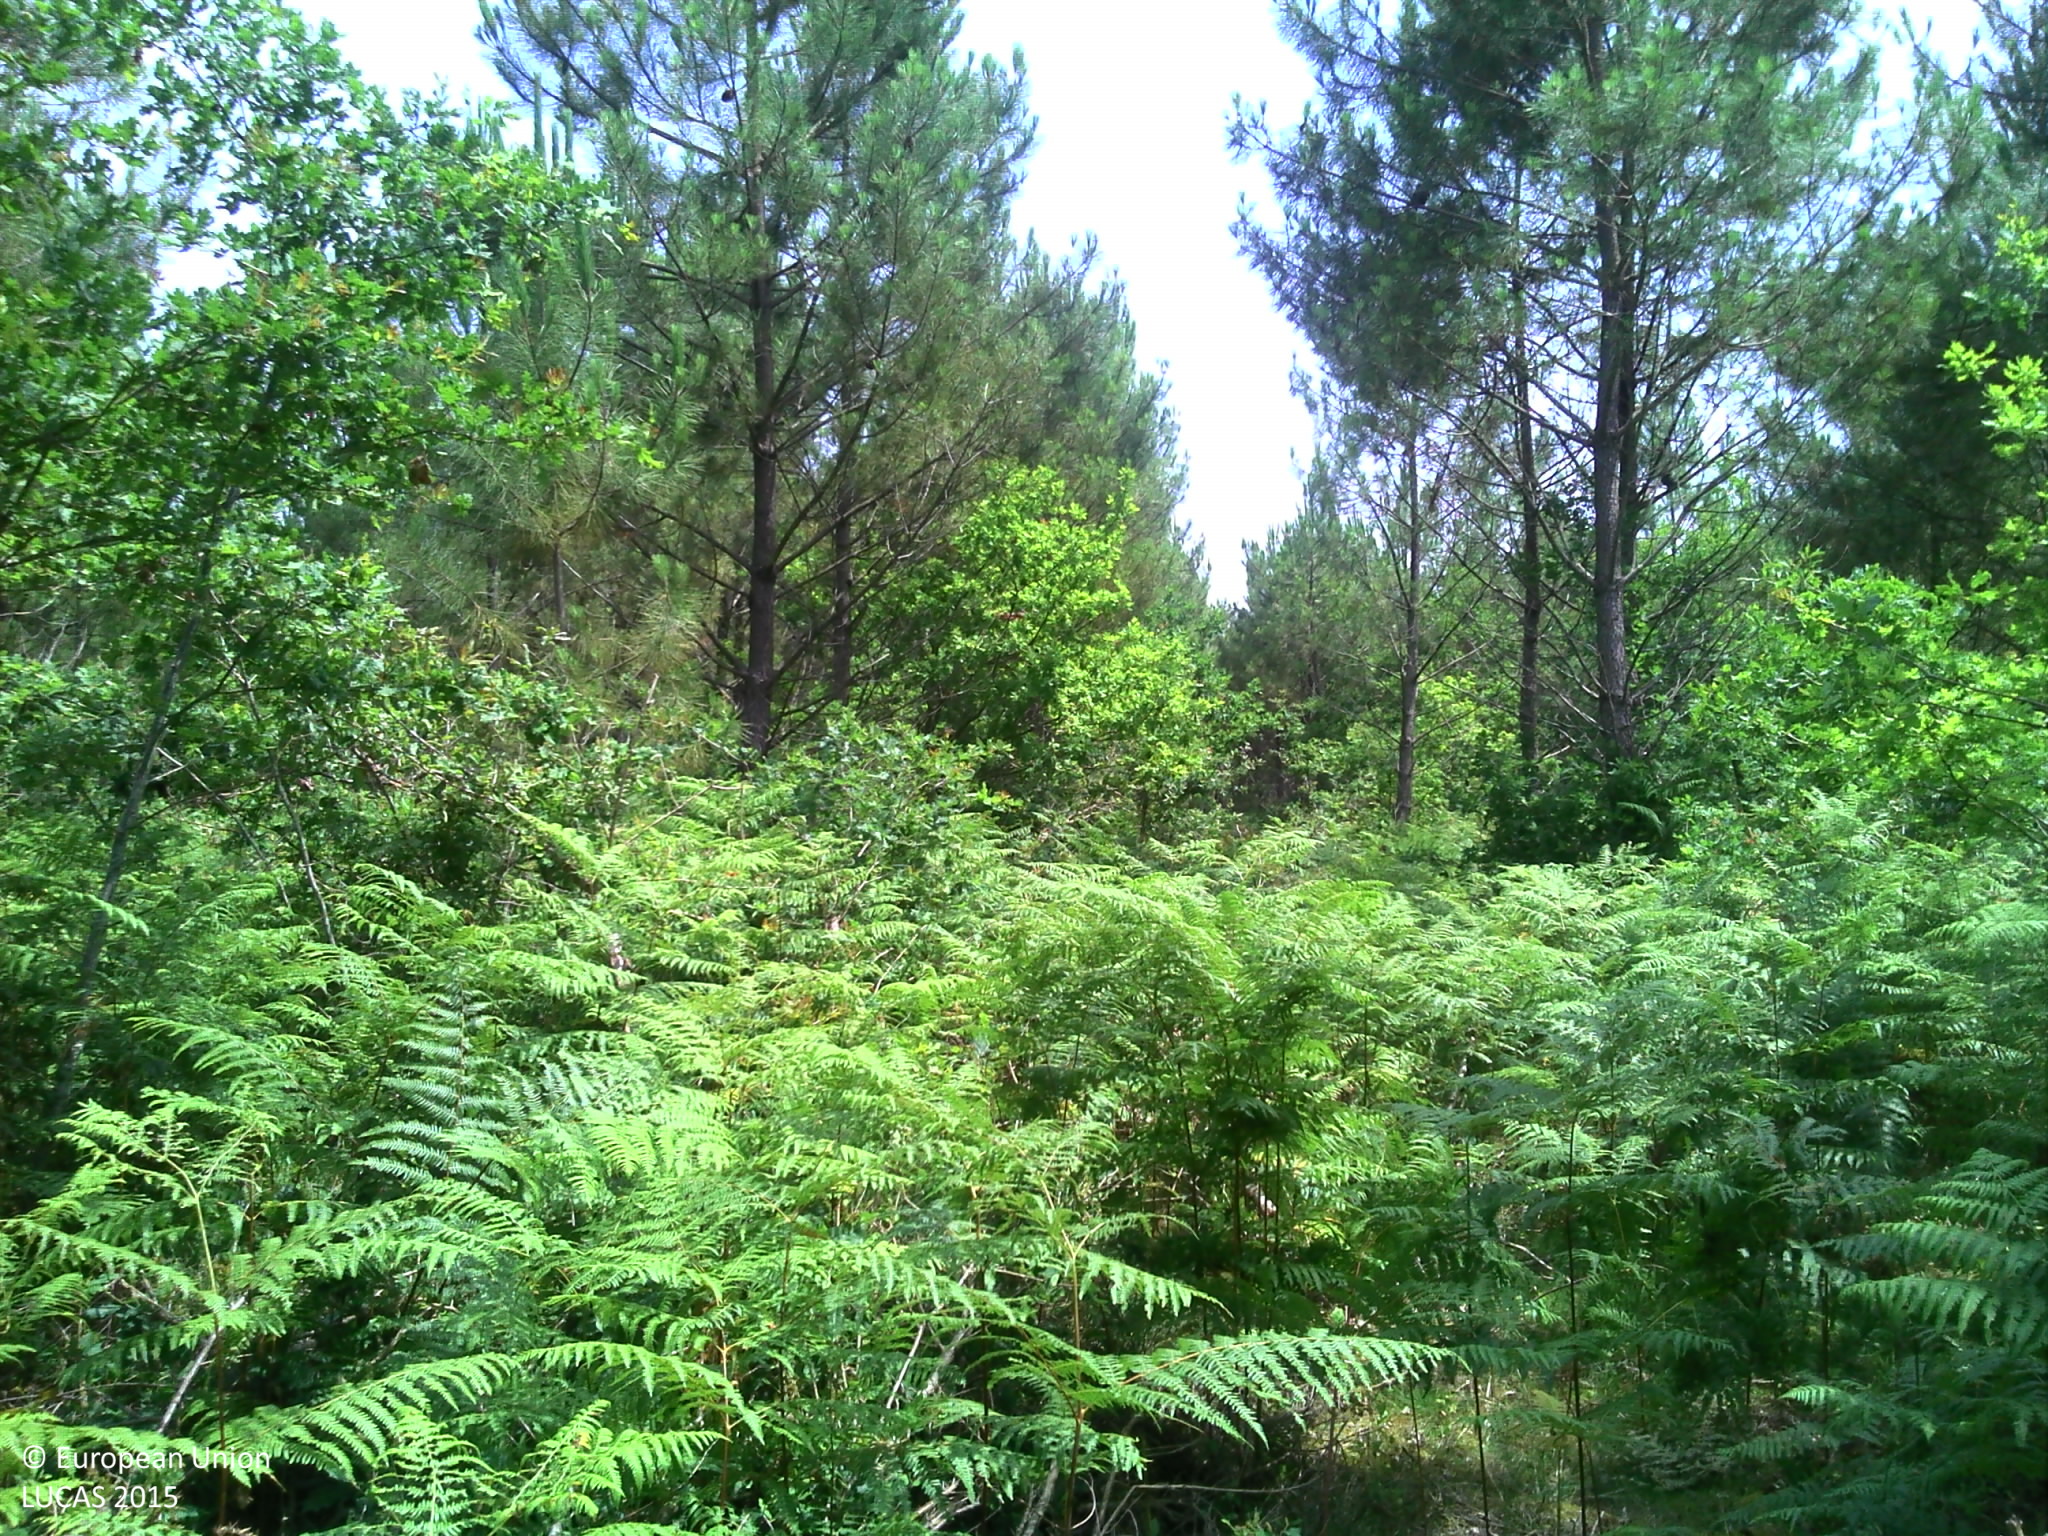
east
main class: Woodland
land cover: Pine dominated mixed woodland
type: coniferous forest of the mediterranean region
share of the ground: > 75 %
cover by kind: herbaceous plants 40 %, coniferous forest trees 30 %, broadleaved forest trees 25 %, shrubs 5 %
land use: Forestry
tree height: < 5 m
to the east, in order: Pine dominated mixed woodland; Pine dominated coniferous woodland; Tracks; Pine dominated coniferous woodland
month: July
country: FR
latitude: 43.8539
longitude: -1.1770
